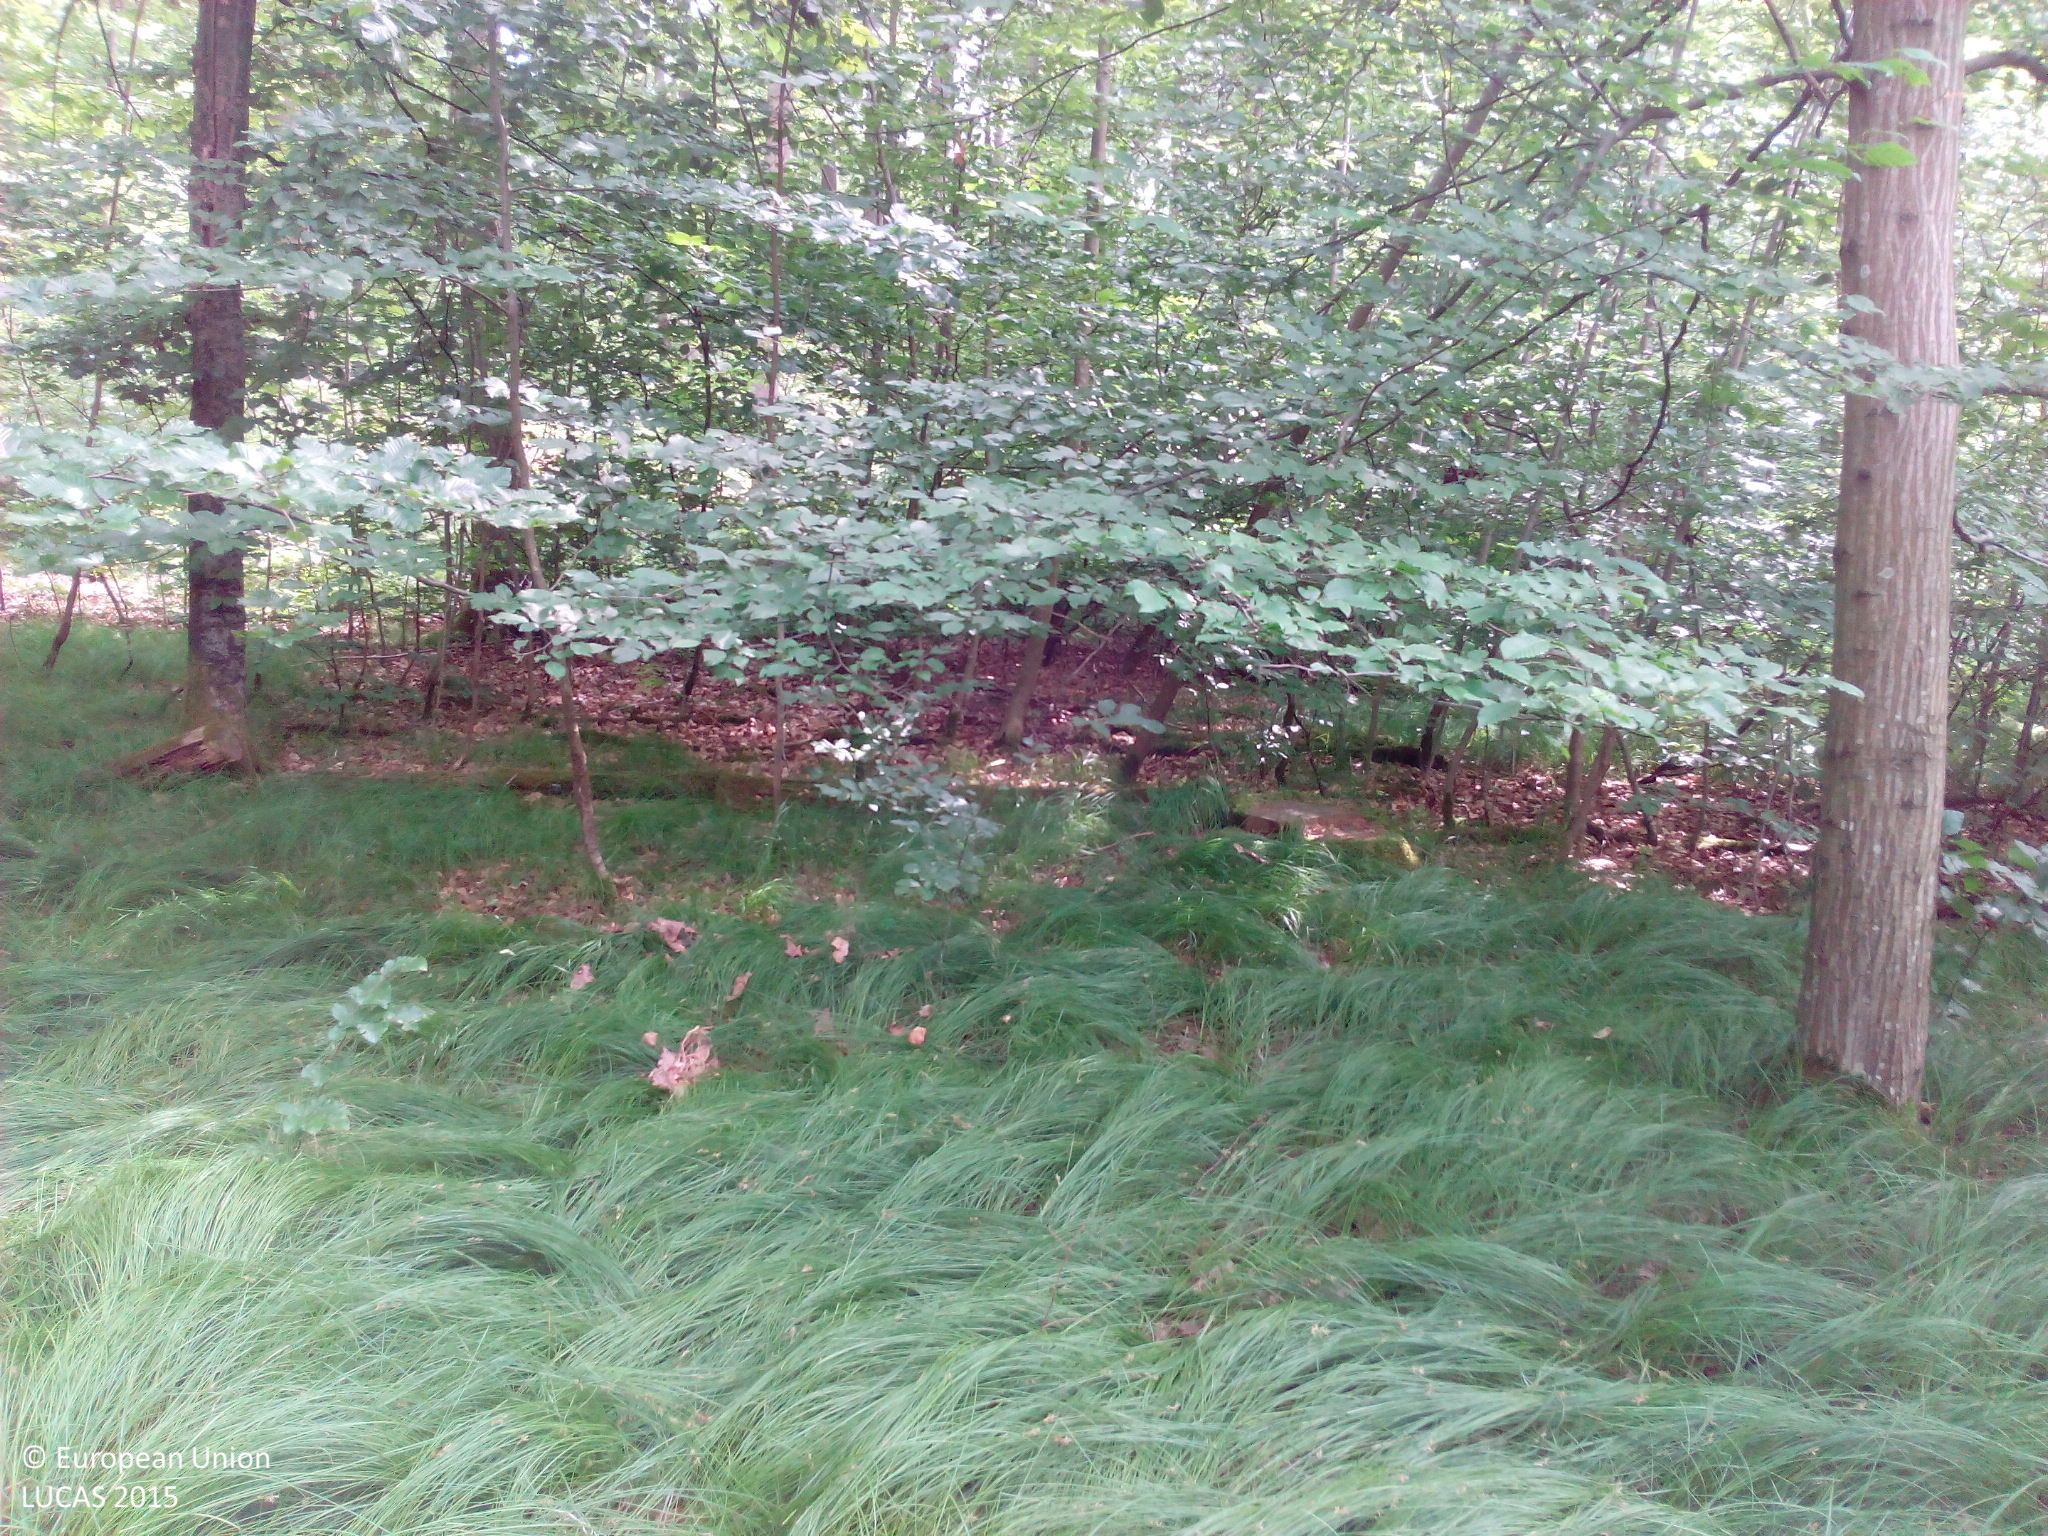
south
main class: Woodland
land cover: Broadleaved woodland
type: mesophytic deciduous forest
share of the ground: > 75 %
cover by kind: broadleaved forest trees 85 %, shrubs 10 %, herbaceous plants 5 %
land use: Forestry
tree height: > 5 m
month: June
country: DE
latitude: 48.7438
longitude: 9.4155
